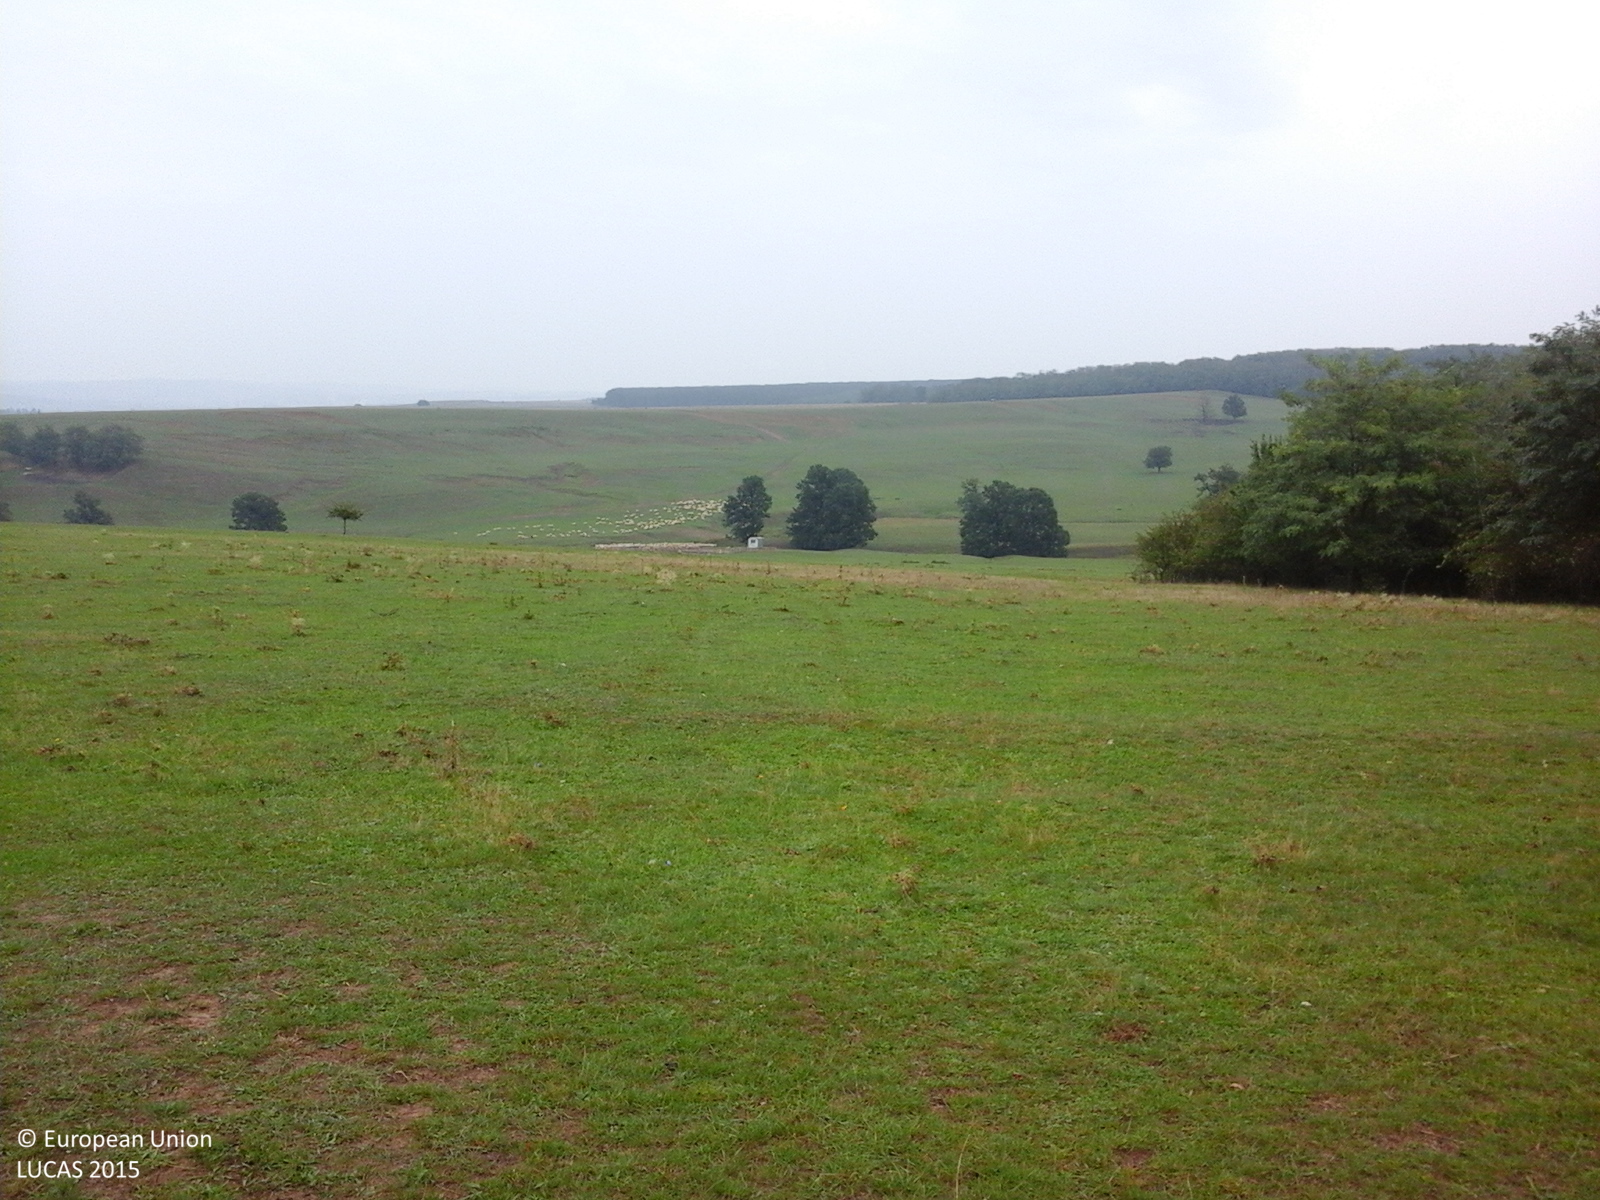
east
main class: Grassland
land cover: Grassland without tree/shrub cover
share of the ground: > 75 %
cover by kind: herbaceous plants 100 %
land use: Agriculture (excluding fallow land and kitchen gardens)
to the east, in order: Grassland without tree/shrub cover
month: September
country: RO
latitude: 47.2818
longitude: 22.4159
